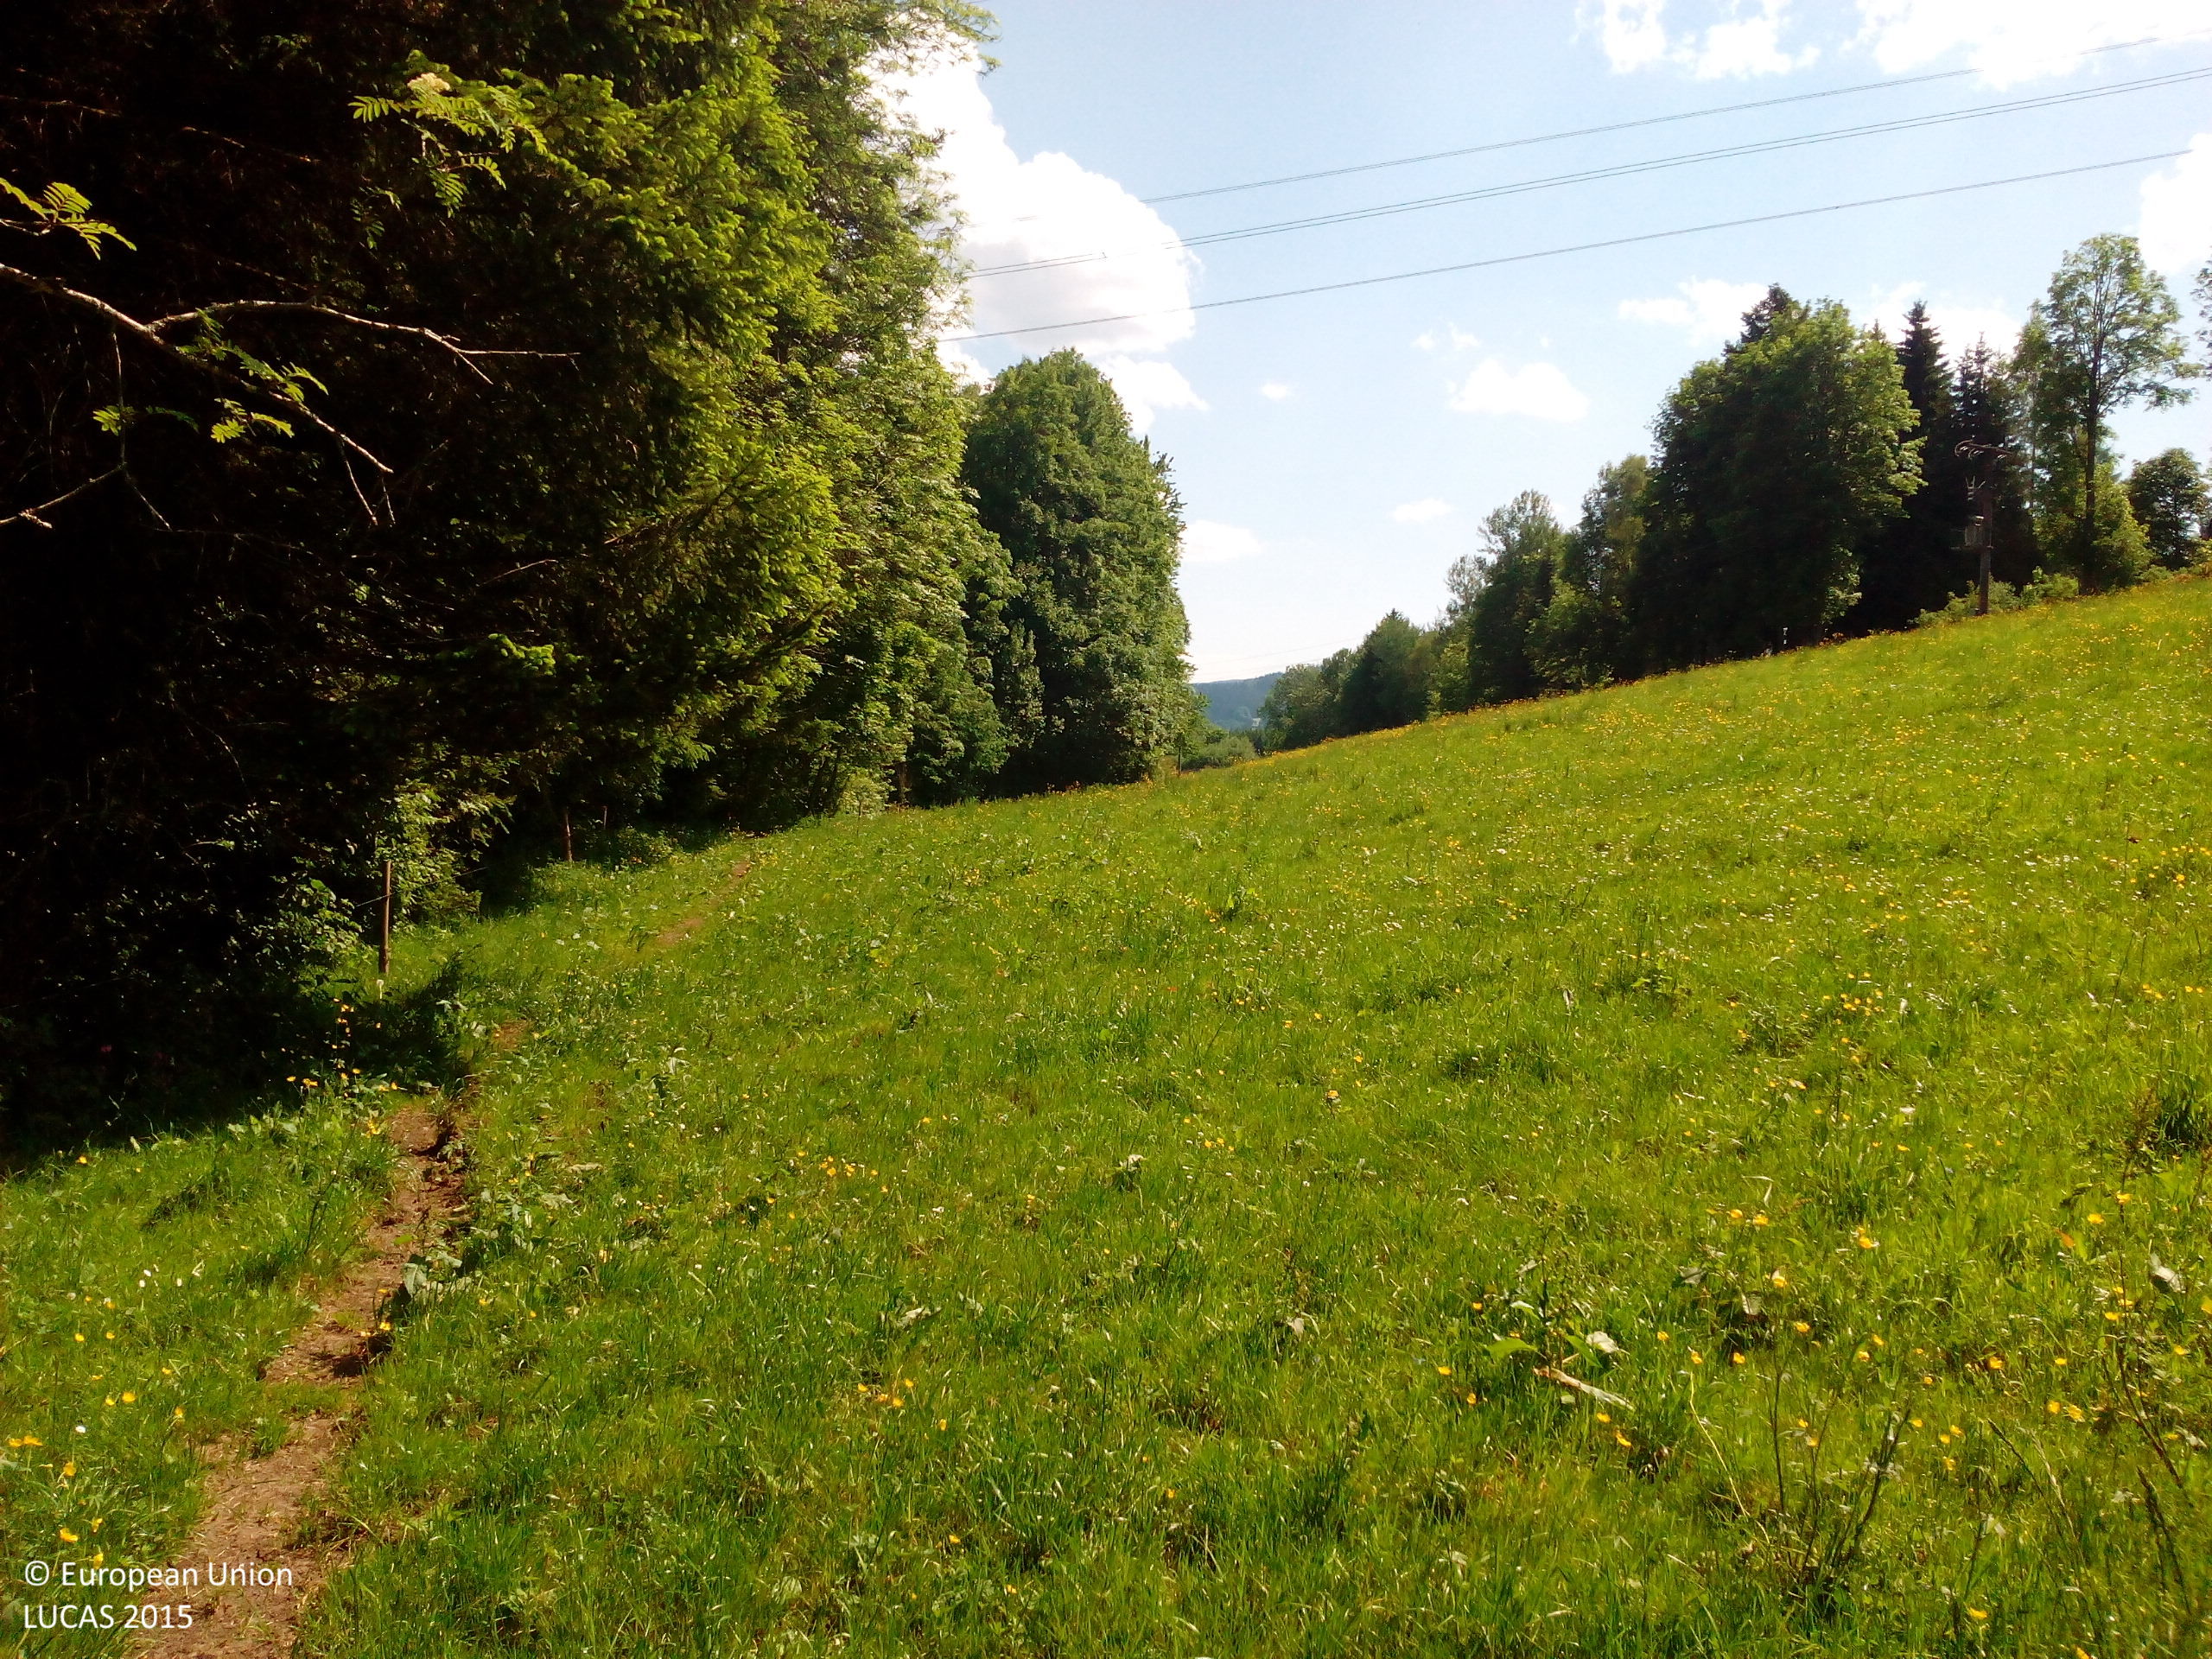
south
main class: Woodland
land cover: Broadleaved woodland
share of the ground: > 75 %
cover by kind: broadleaved forest trees 80 %, shrubs 10 %, herbaceous plants 10 %
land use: Forestry
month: June
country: DE
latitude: 47.9194
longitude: 8.1143
